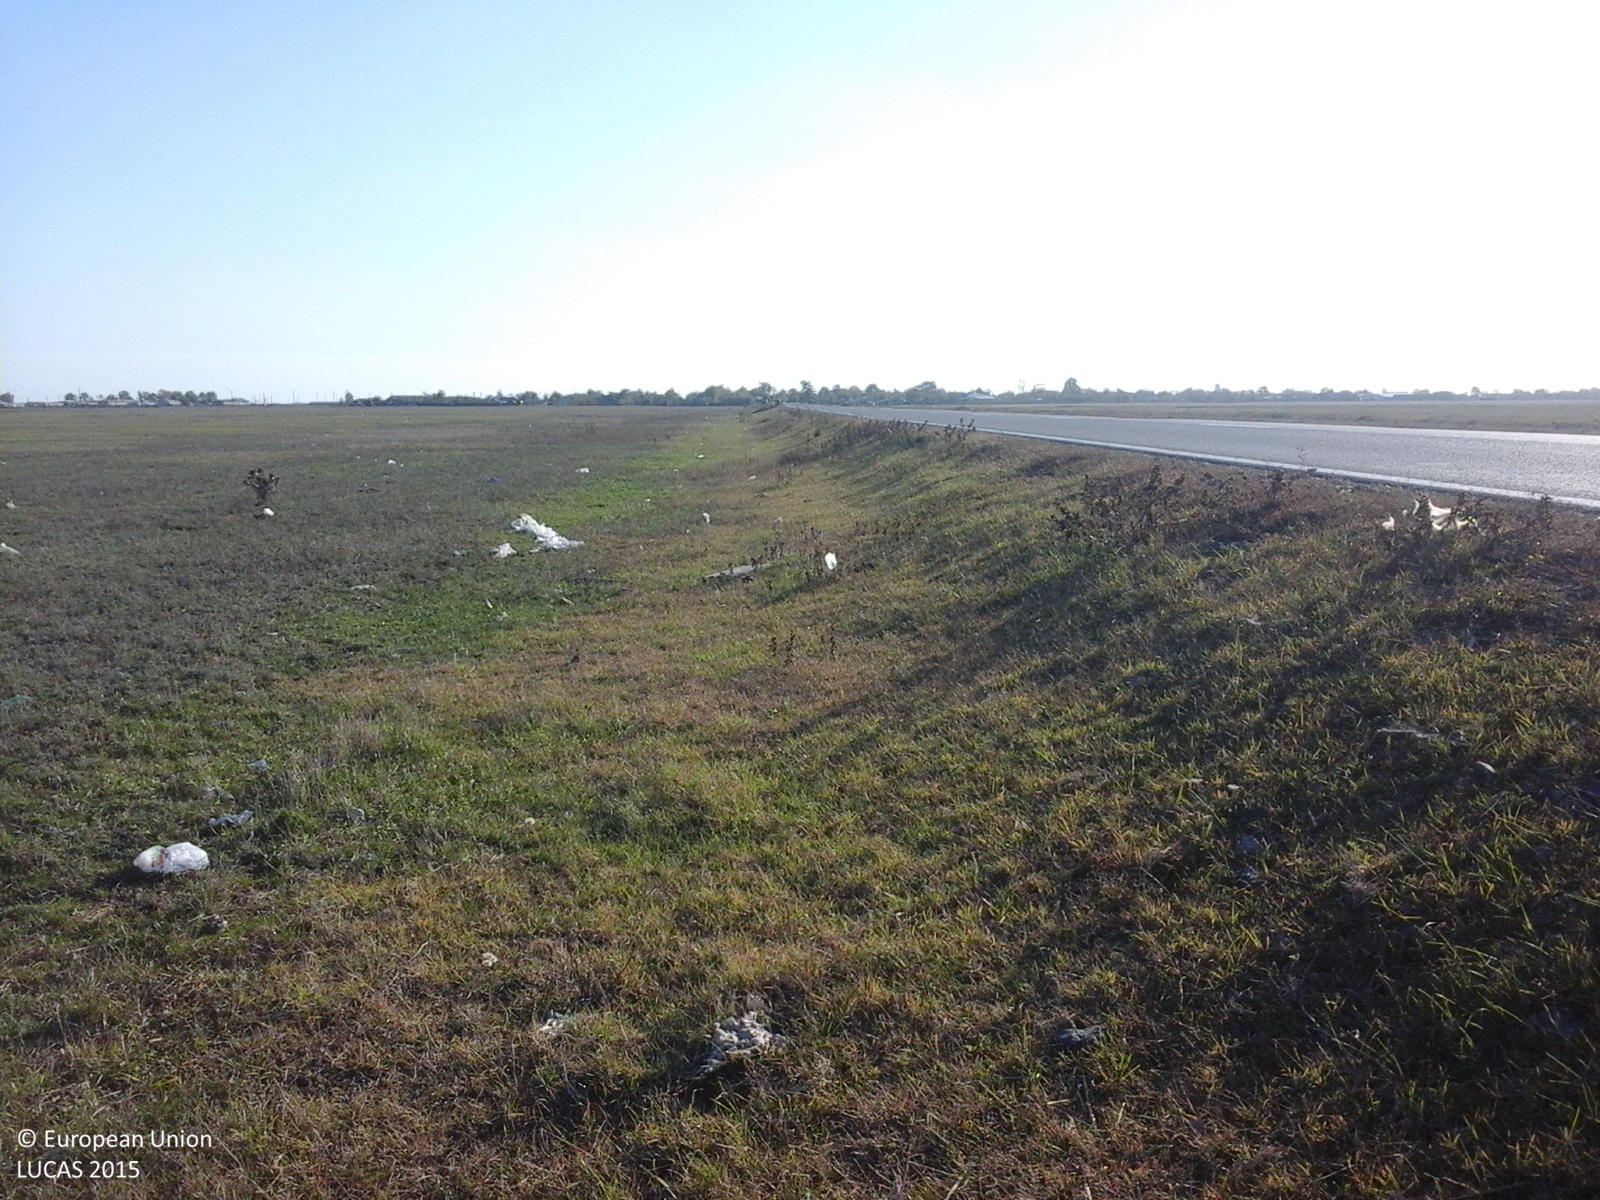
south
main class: Grassland
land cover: Grassland without tree/shrub cover
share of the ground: > 75 %
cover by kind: herbaceous plants 100 %
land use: Agriculture (excluding fallow land and kitchen gardens)
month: October
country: RO
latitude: 45.4417
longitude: 27.5279
